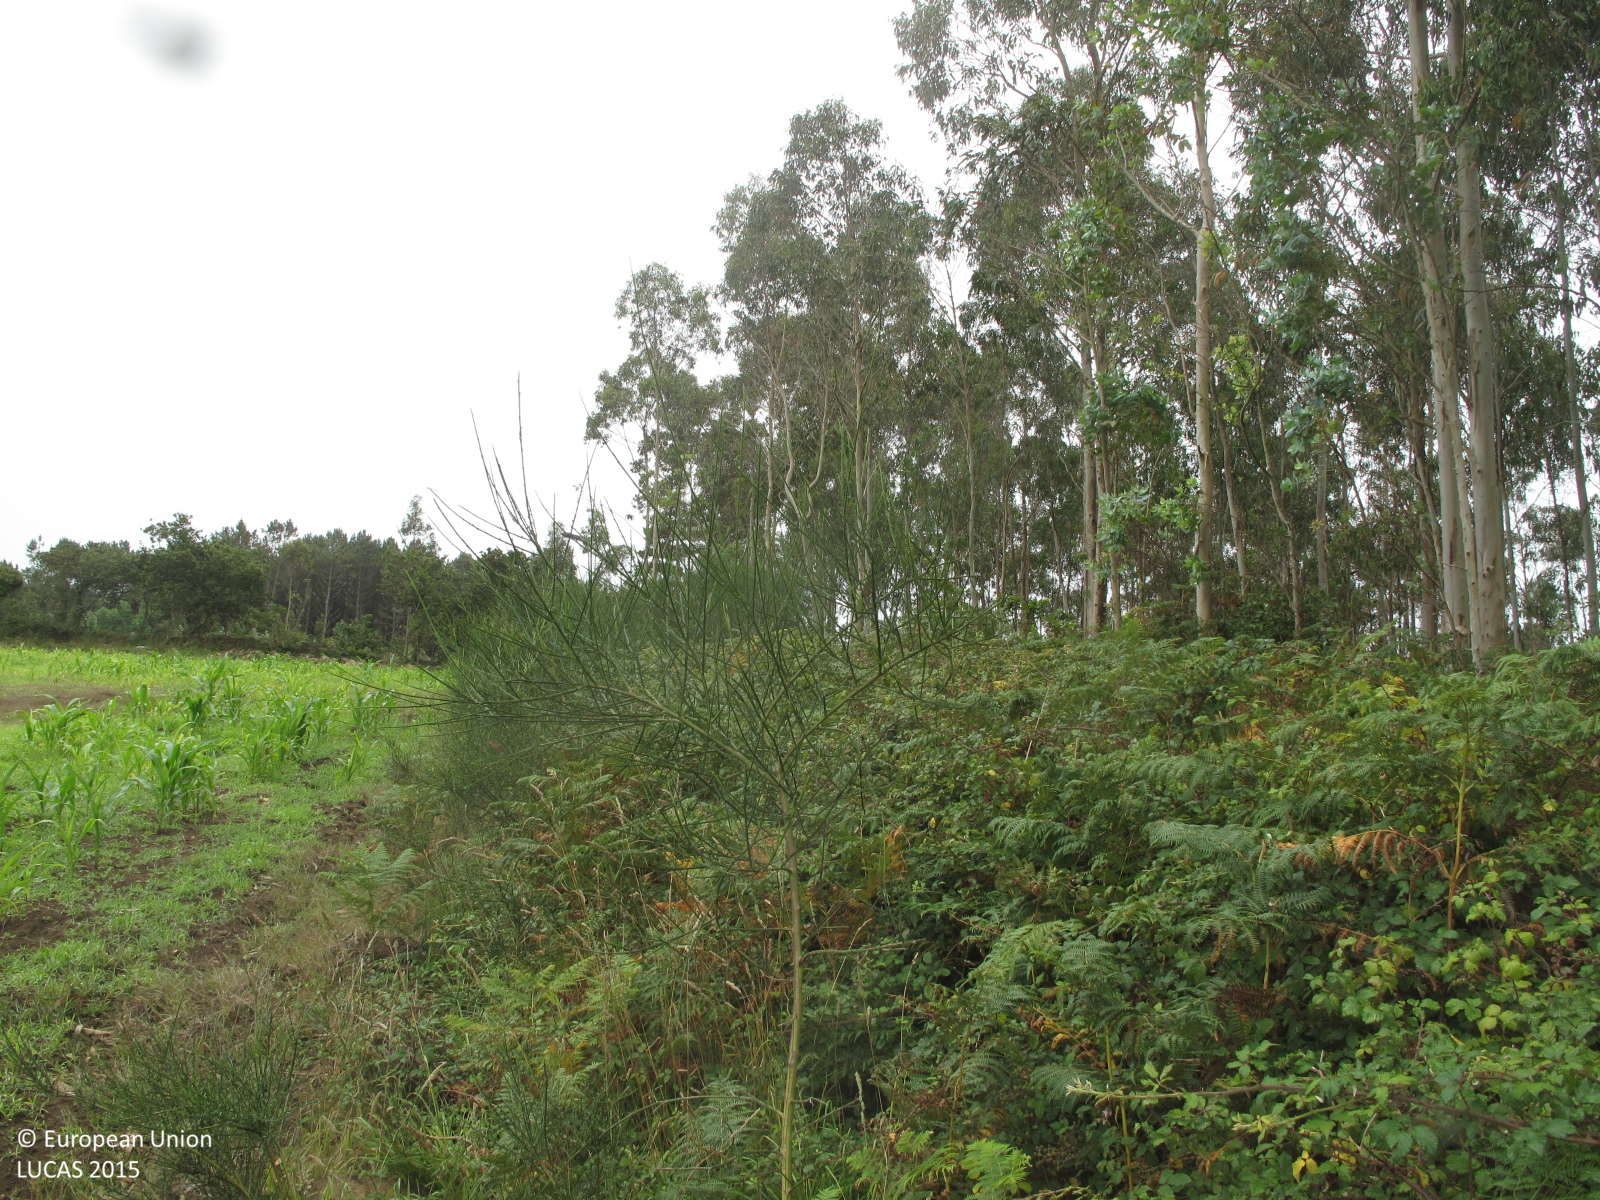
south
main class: Woodland
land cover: Broadleaved woodland
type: exotic forest
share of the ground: 50 - 75 %
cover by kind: broadleaved forest trees 50 %, shrubs 30 %, herbaceous plants 20 %
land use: Forestry
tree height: > 5 m
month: July
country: ES
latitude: 43.0289
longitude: -9.2378
